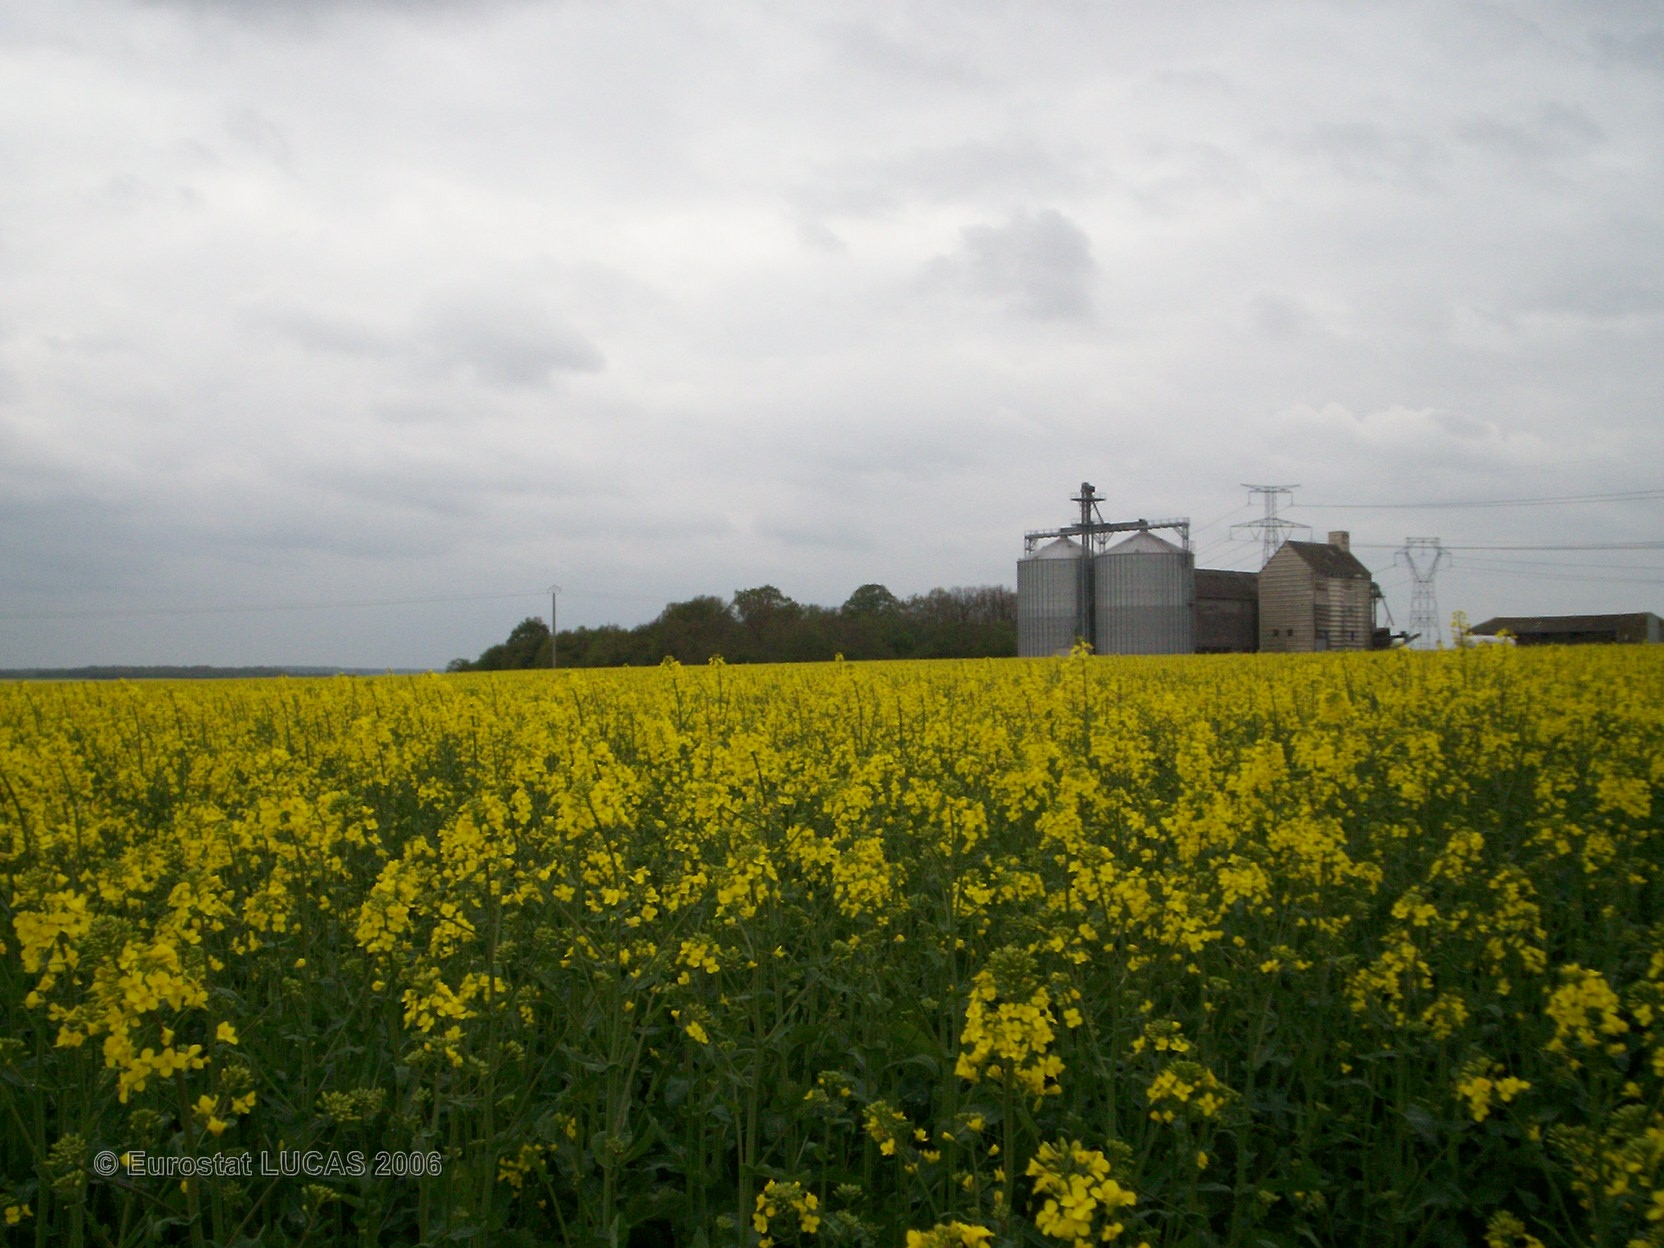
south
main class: Cropland
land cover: Rape and turnip rape
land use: Agriculture (excluding fallow land and kitchen gardens)
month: May
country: FR
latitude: 48.1183
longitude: 2.8589
